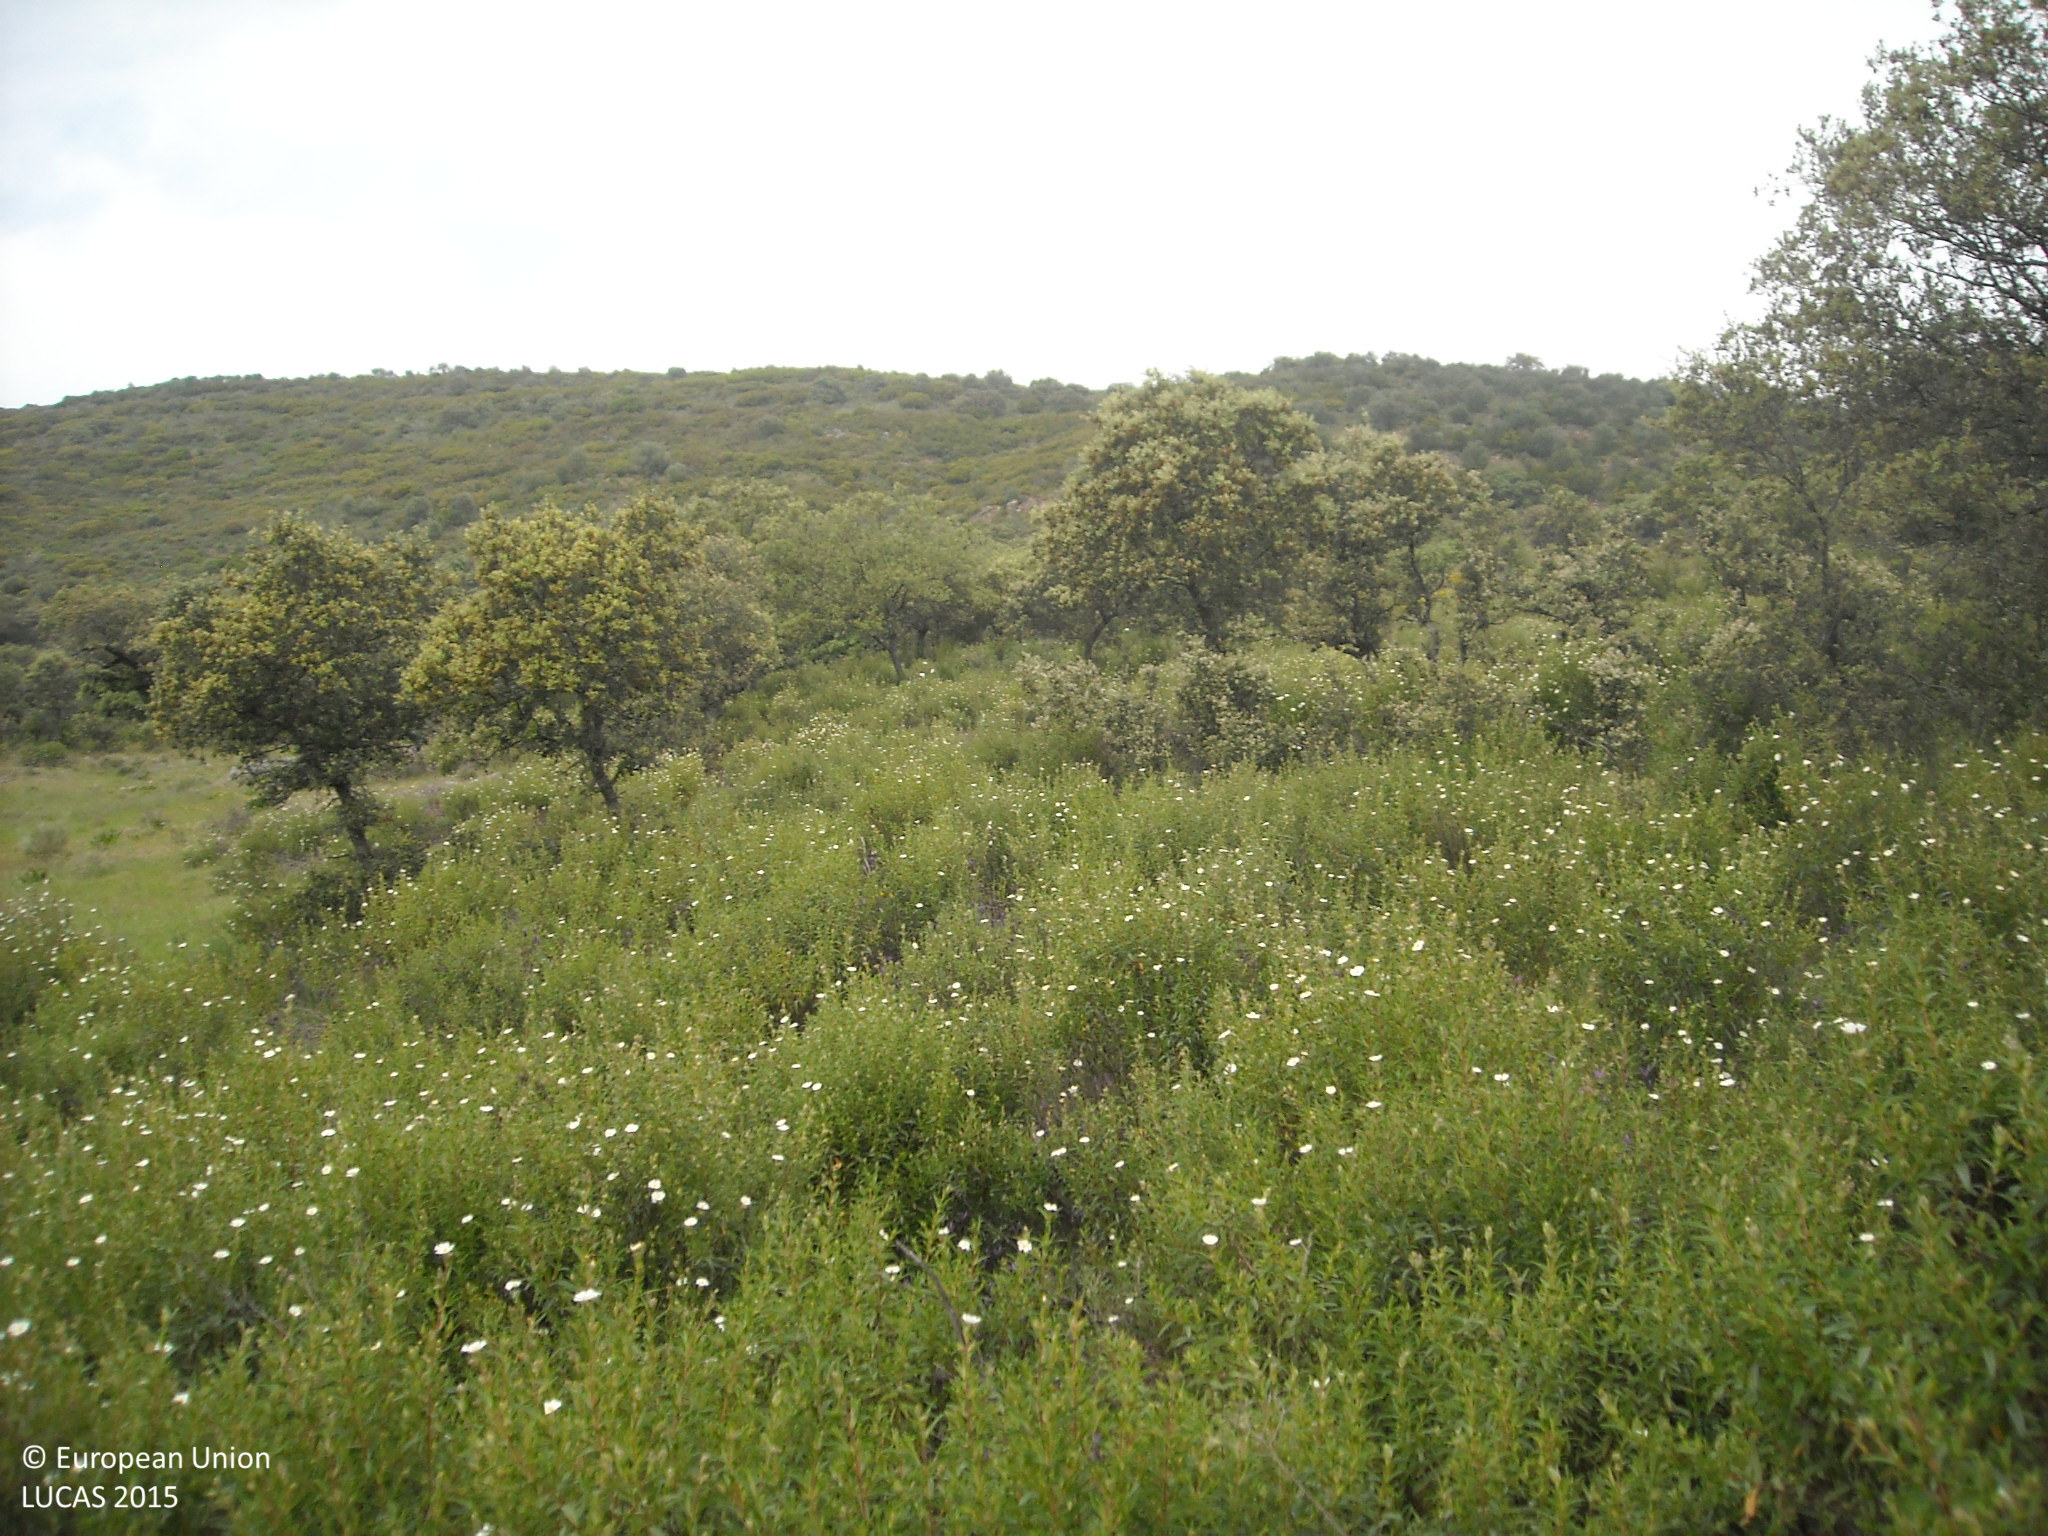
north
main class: Woodland
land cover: Broadleaved woodland
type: broadleaved evergreen forest
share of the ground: 10 - 25 %
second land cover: Shrubland without tree cover
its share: > 75 %
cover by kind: shrubs 75 %, broadleaved forest trees 20 %, herbaceous plants 5 %
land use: Forestry
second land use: Agriculture (excluding fallow land and kitchen gardens)
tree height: > 5 m
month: April
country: ES
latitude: 37.9182
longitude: -6.2942
